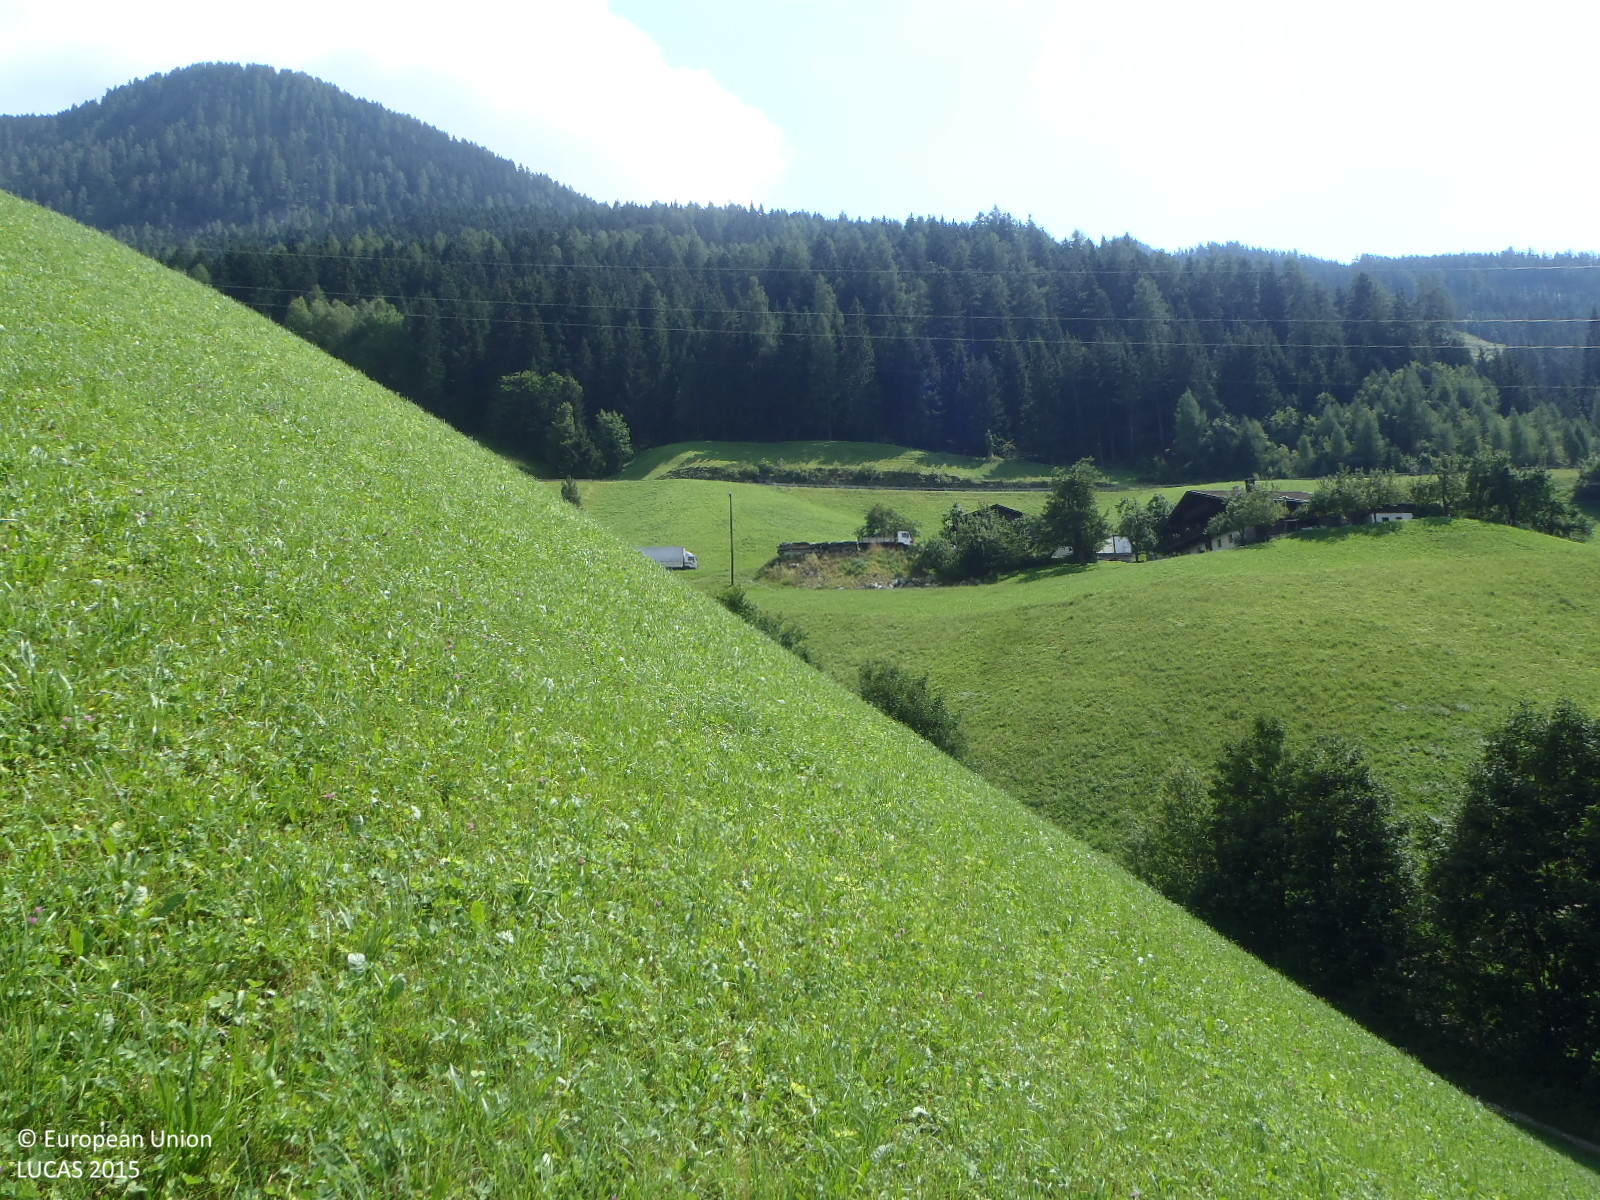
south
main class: Grassland
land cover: Grassland without tree/shrub cover
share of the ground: > 75 %
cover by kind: herbaceous plants 100 %
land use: Agriculture (excluding fallow land and kitchen gardens)
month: July
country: AT
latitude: 47.2167
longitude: 11.9130
